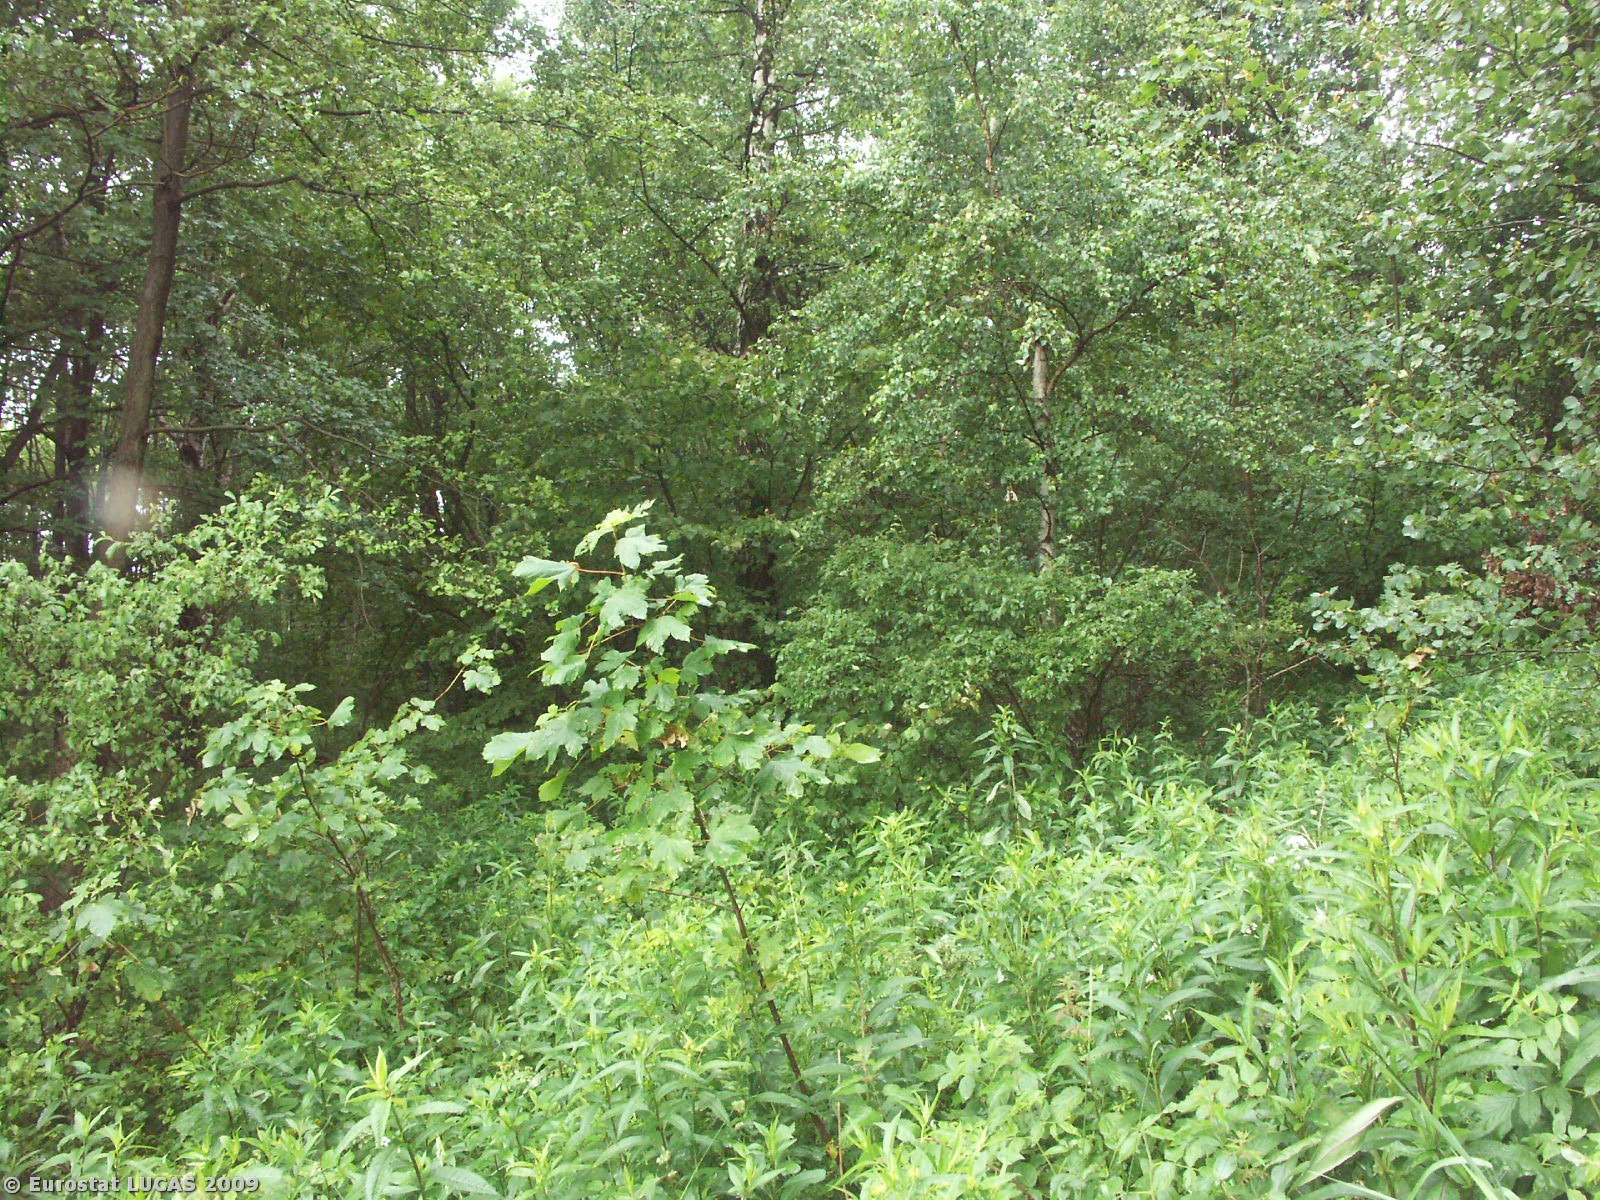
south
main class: Woodland
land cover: Broadleaved woodland
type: mesophytic deciduous forest
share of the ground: > 75 %
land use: Forestry
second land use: Nature reserves
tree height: > 5 m
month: July
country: CZ
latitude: 49.9197
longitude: 17.2115
